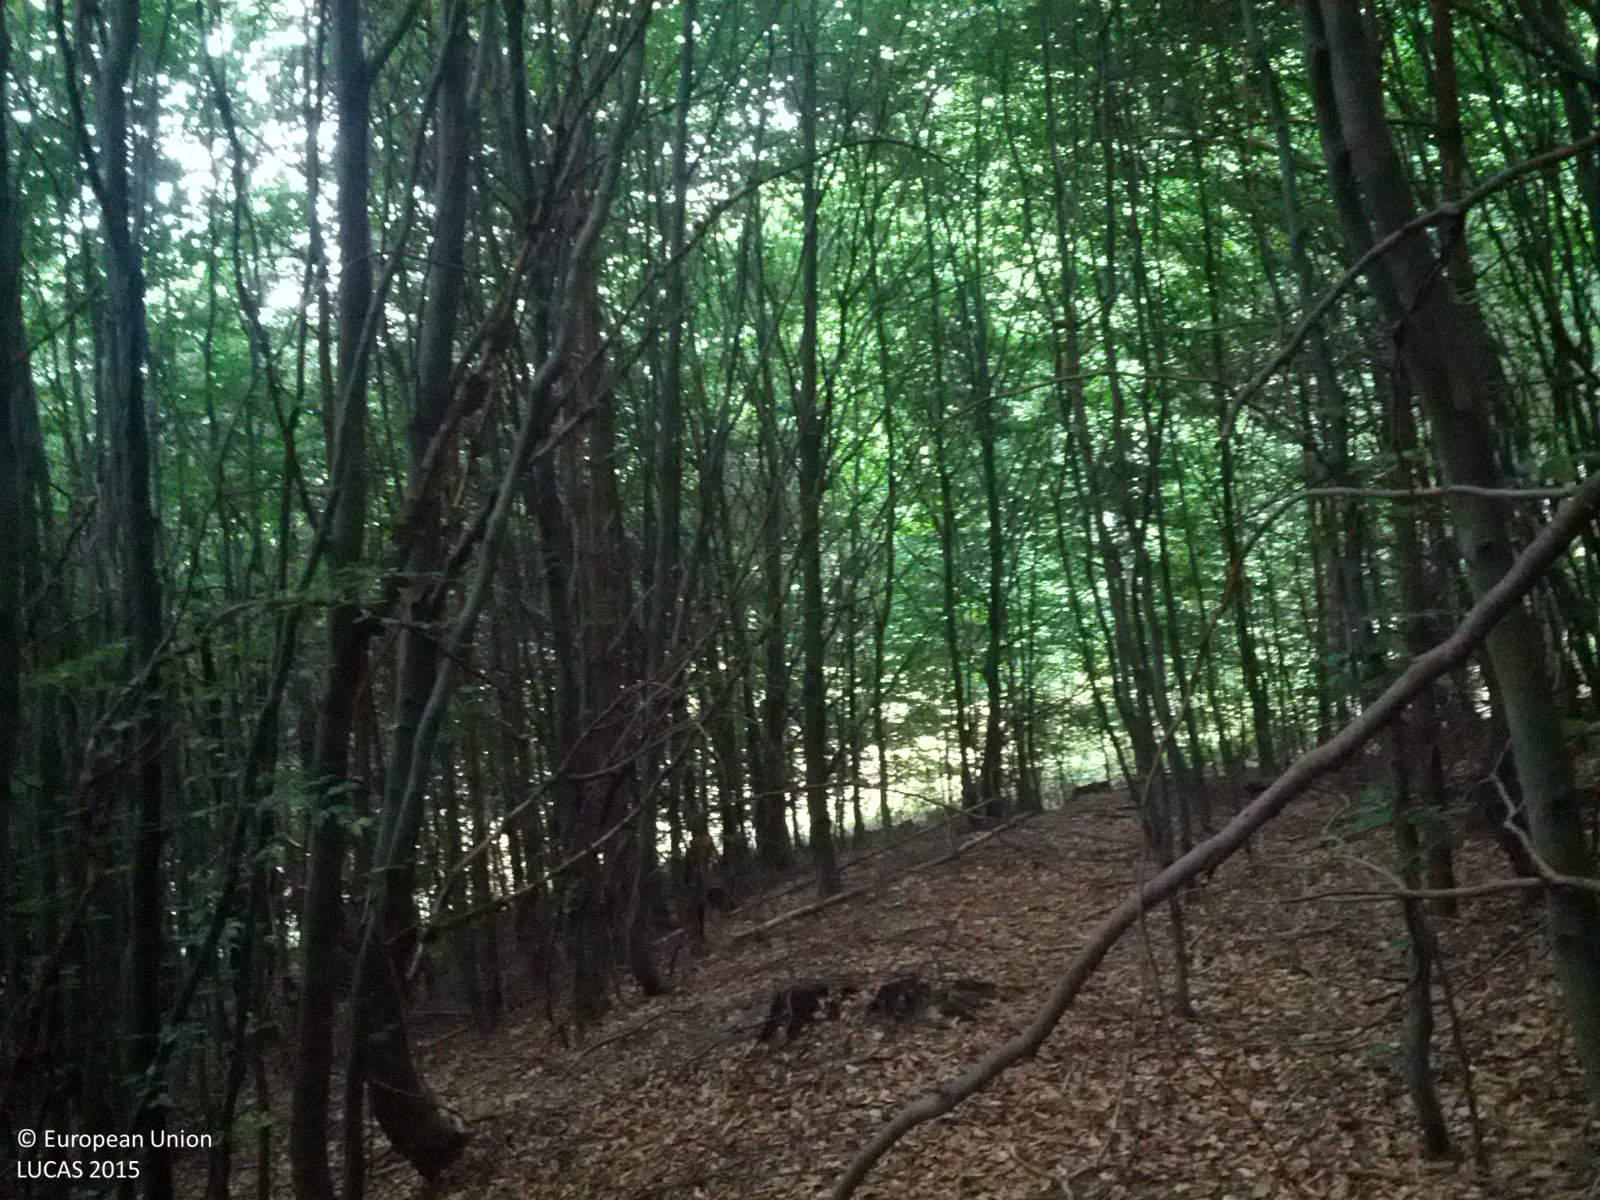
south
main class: Woodland
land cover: Broadleaved woodland
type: beech forest
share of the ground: > 75 %
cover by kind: broadleaved forest trees 100 %
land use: Forestry
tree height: > 5 m
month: June
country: AT
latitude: 48.2170
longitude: 16.1010
